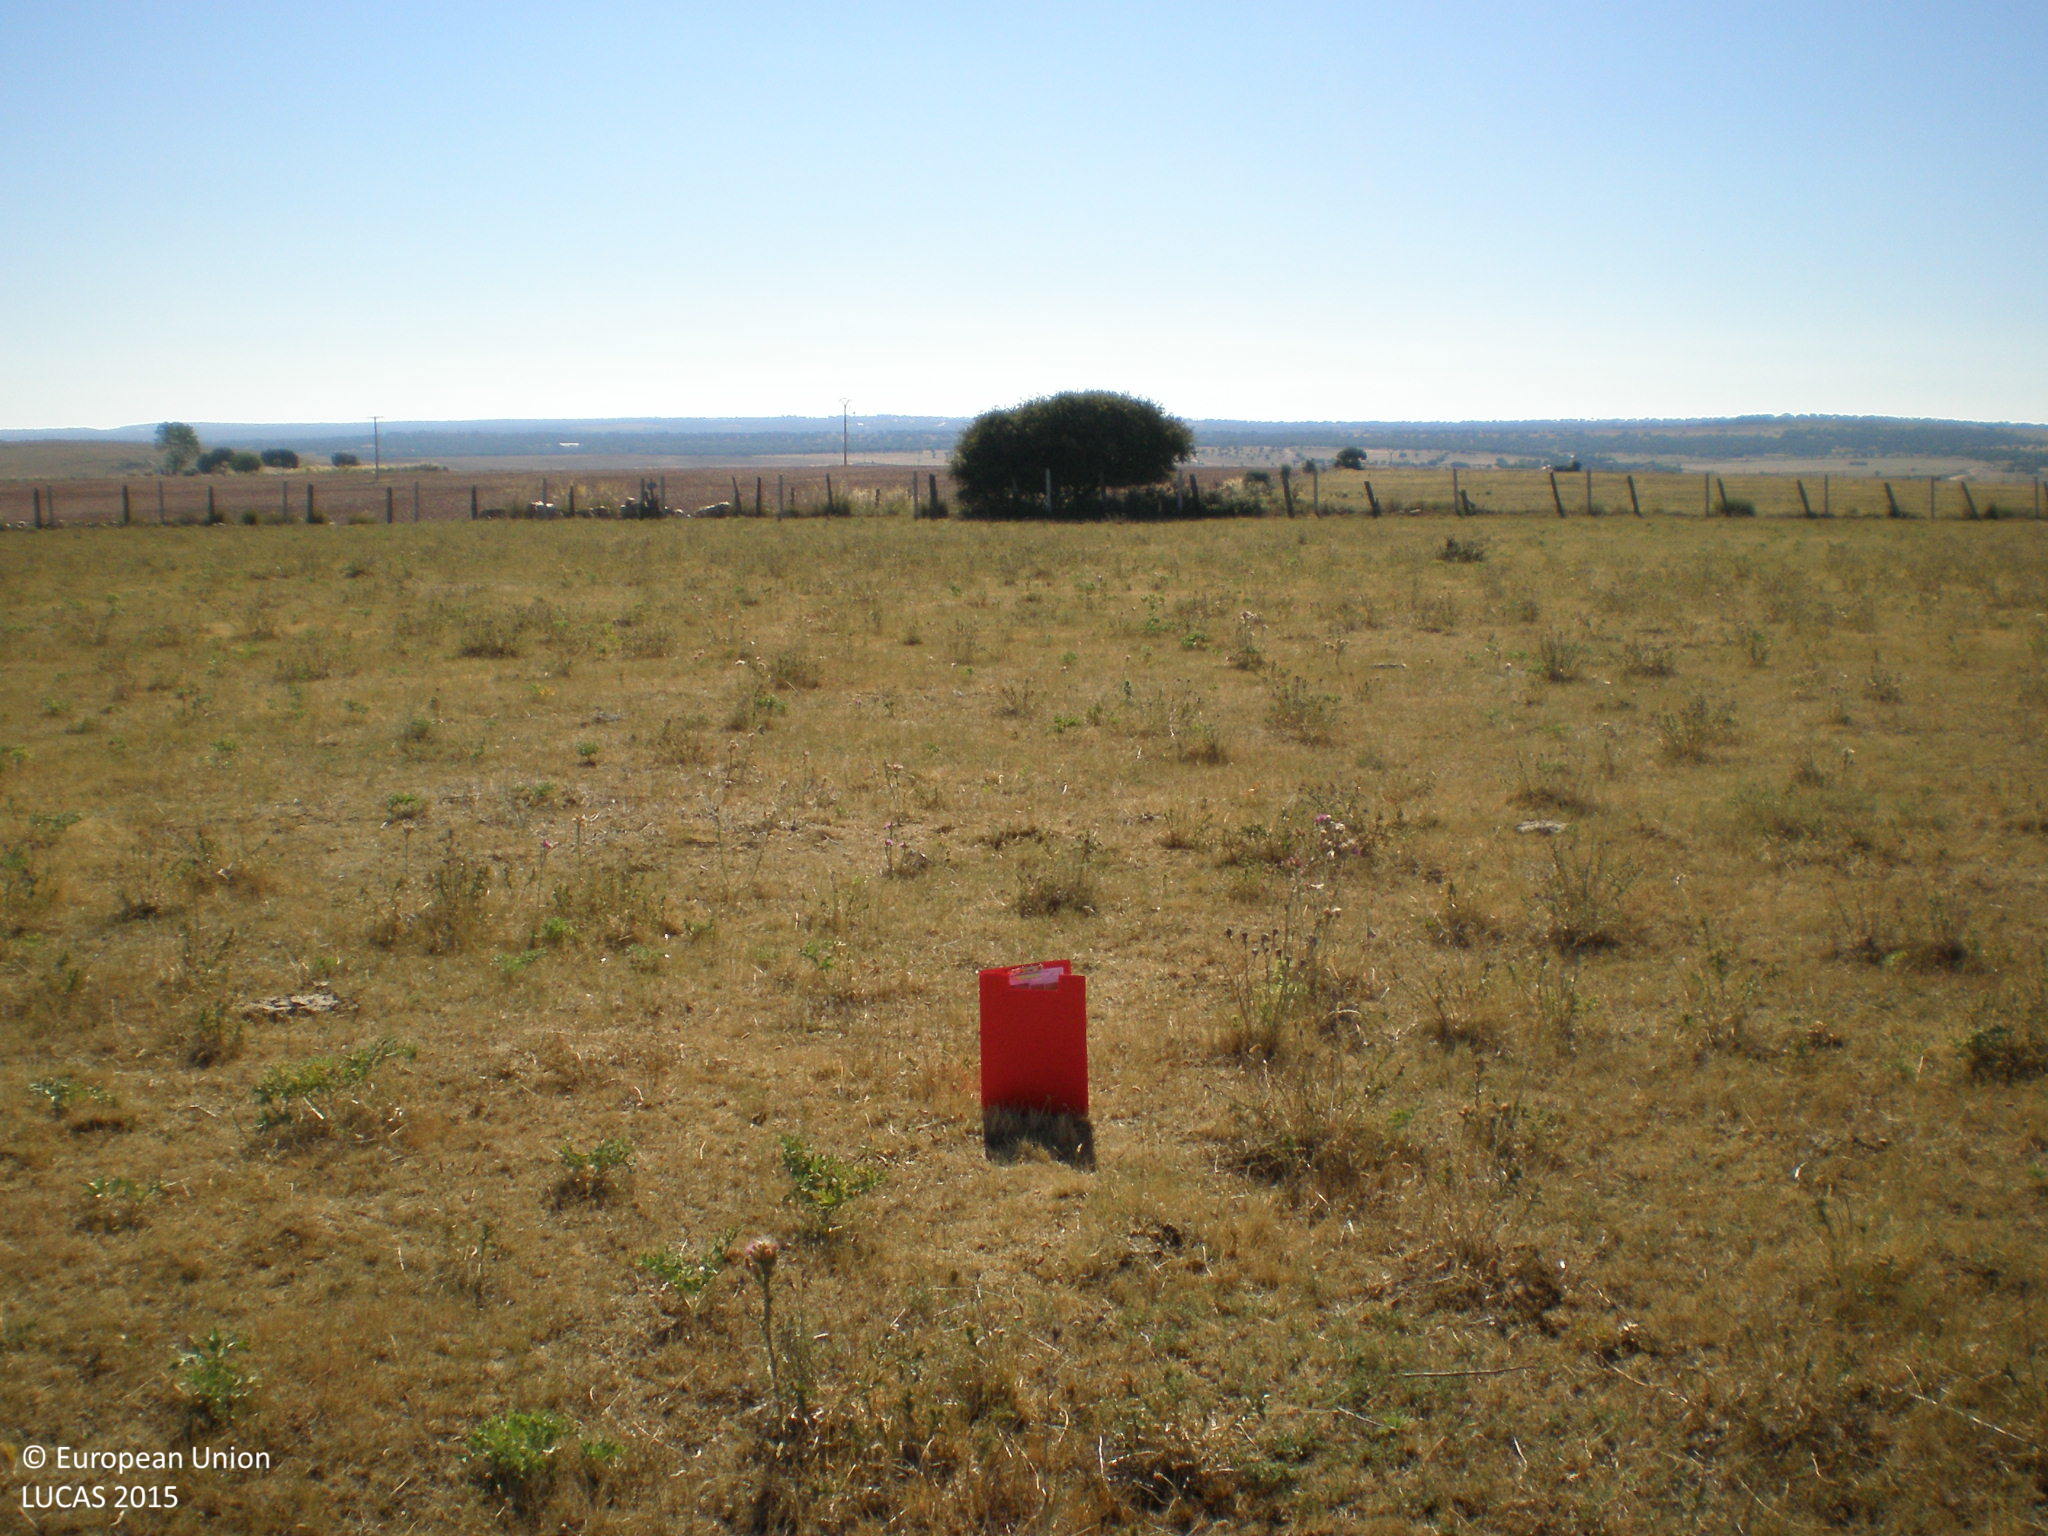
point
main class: Grassland
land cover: Grassland without tree/shrub cover
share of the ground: > 75 %
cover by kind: herbaceous plants 100 %
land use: Agriculture (excluding fallow land and kitchen gardens)
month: June
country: ES
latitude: 40.8125
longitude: -5.7127
